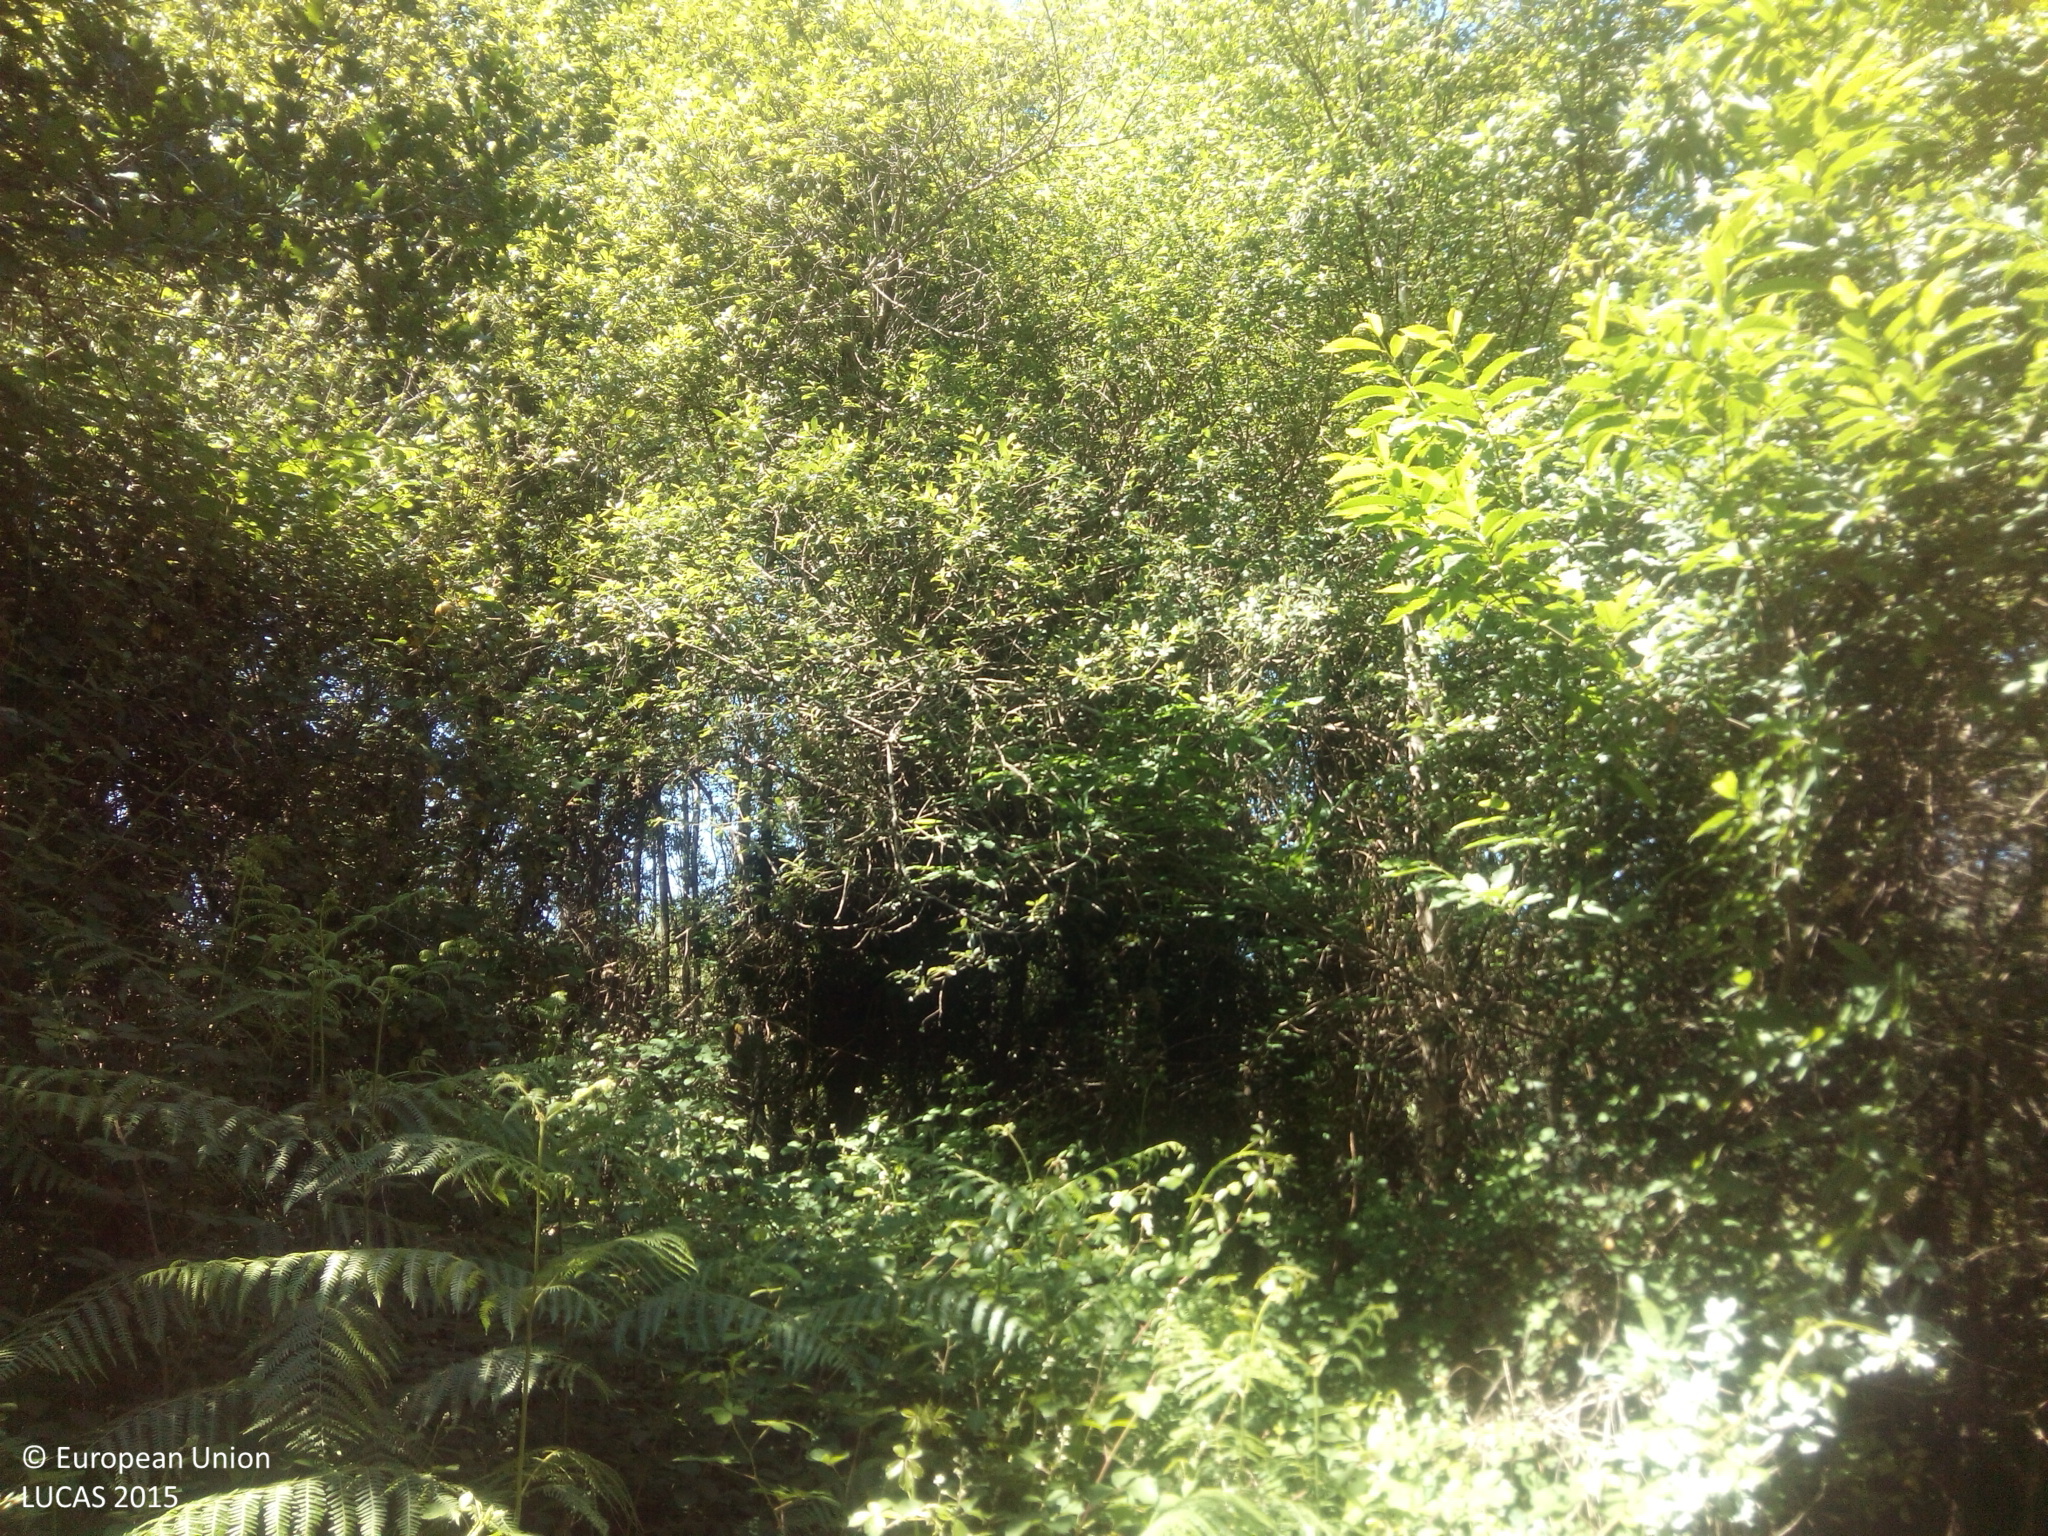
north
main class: Woodland
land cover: Broadleaved woodland
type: acidophilous oak and oak-birch forest
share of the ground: > 75 %
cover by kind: broadleaved forest trees 100 %
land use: Forestry
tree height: > 5 m
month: June
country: ES
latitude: 42.4793
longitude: -8.3272
